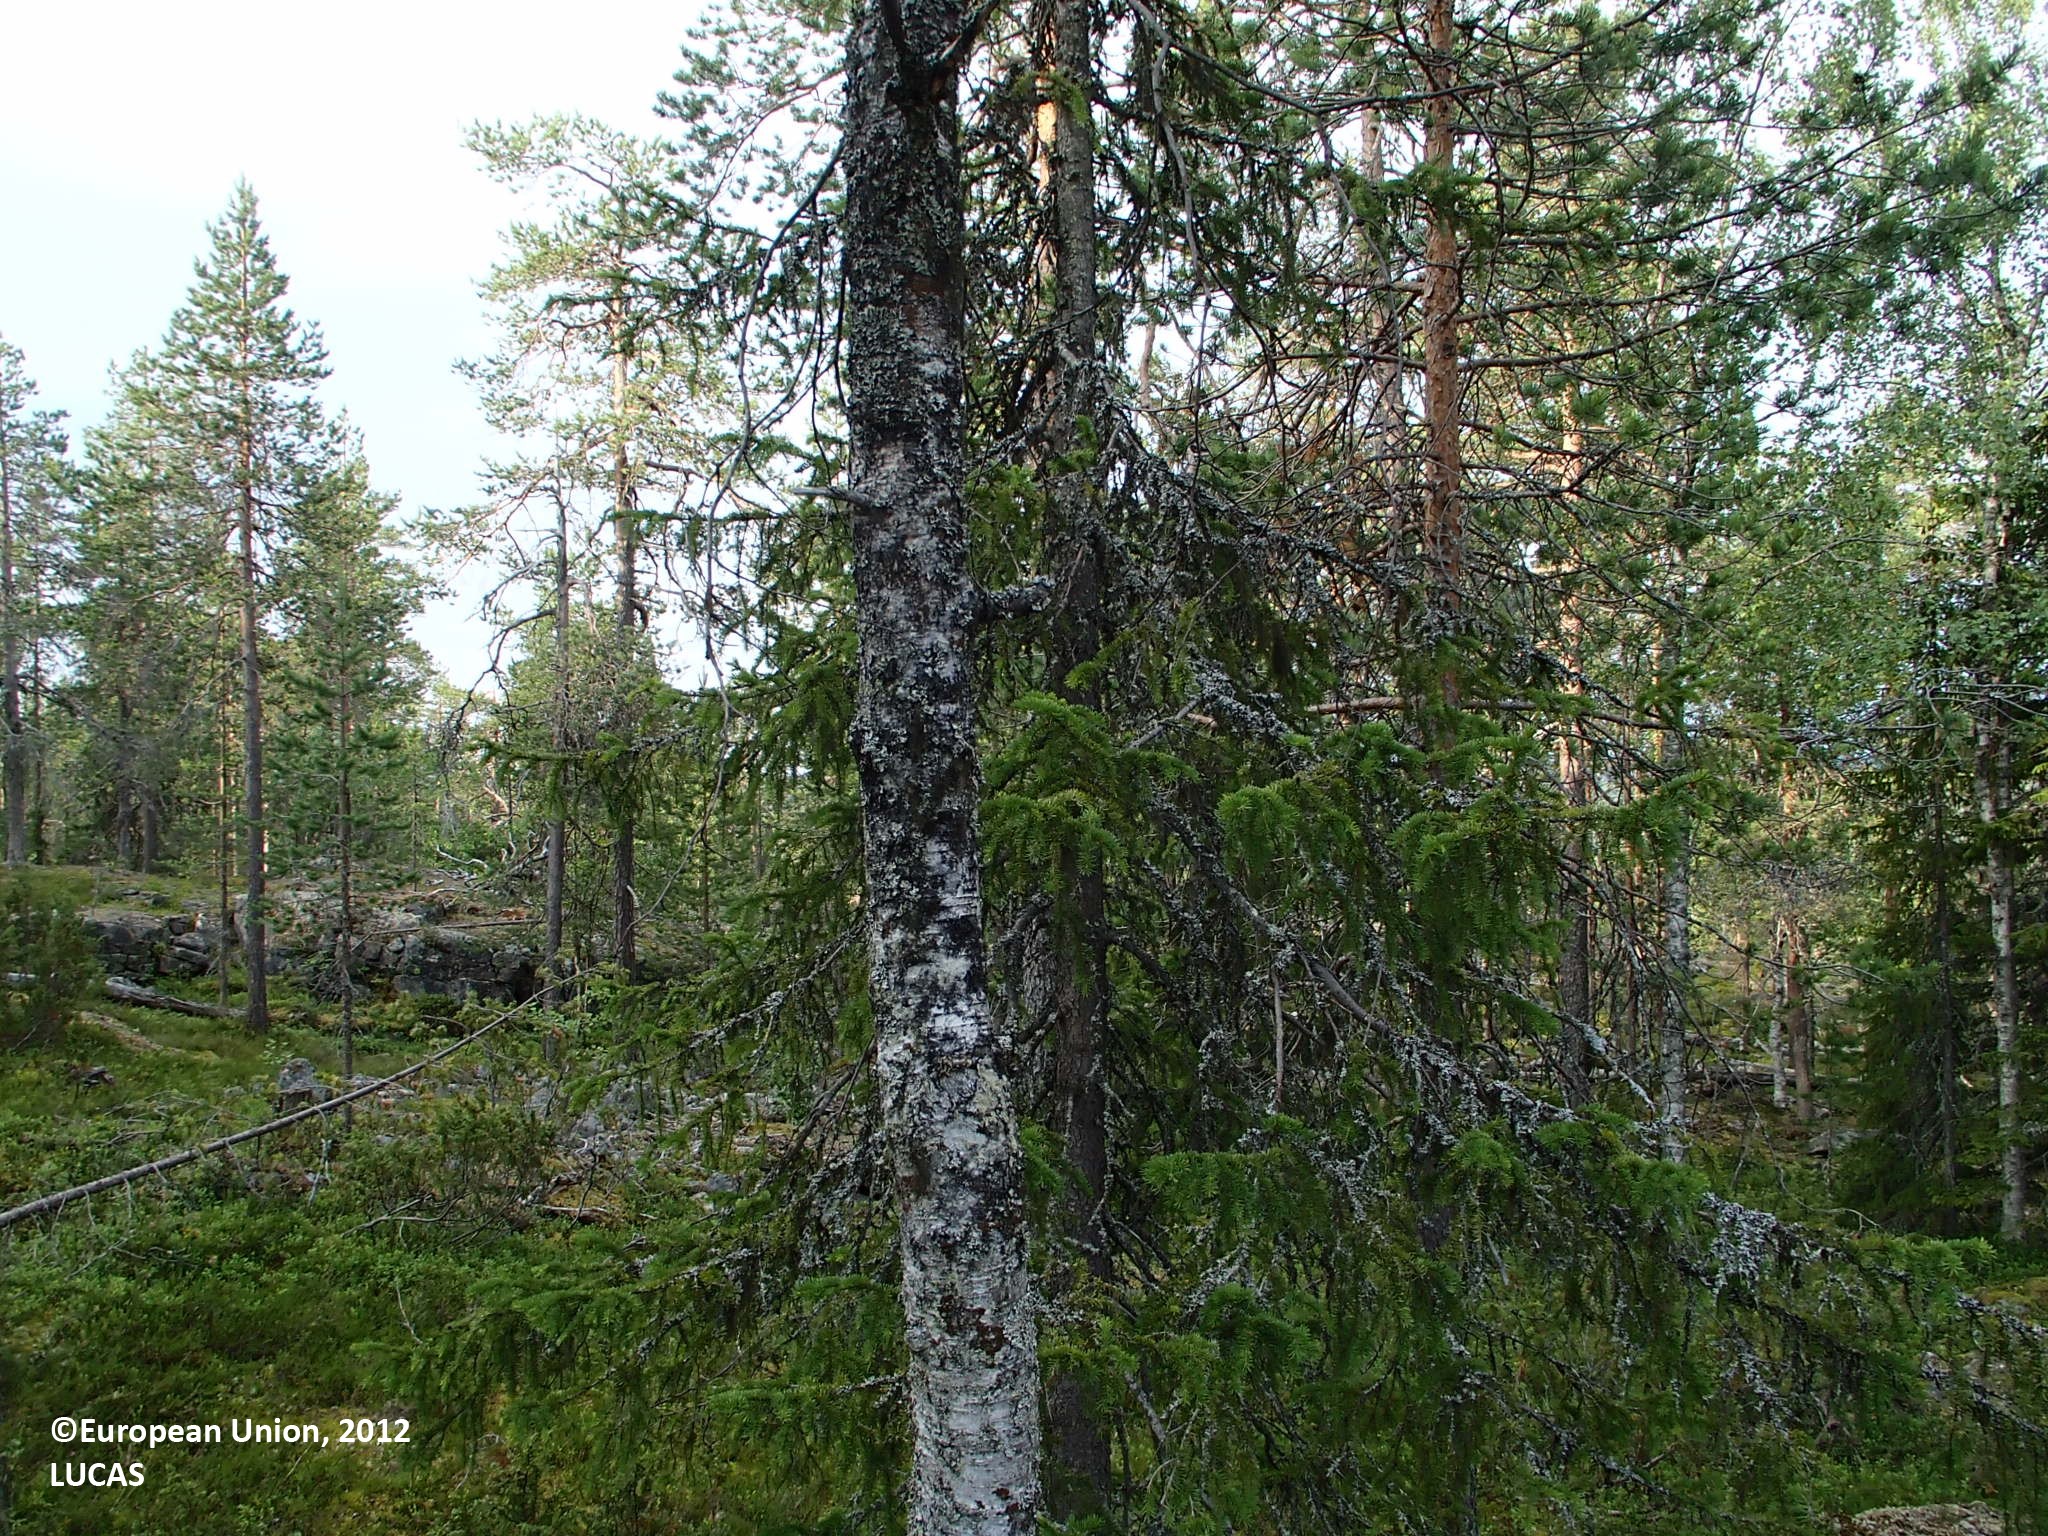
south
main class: Woodland
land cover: Other mixed woodland
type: boreal forest
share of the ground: 25 - 50 %
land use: Forestry
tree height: > 5 m
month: July
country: FI
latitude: 66.6217
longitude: 25.5792
